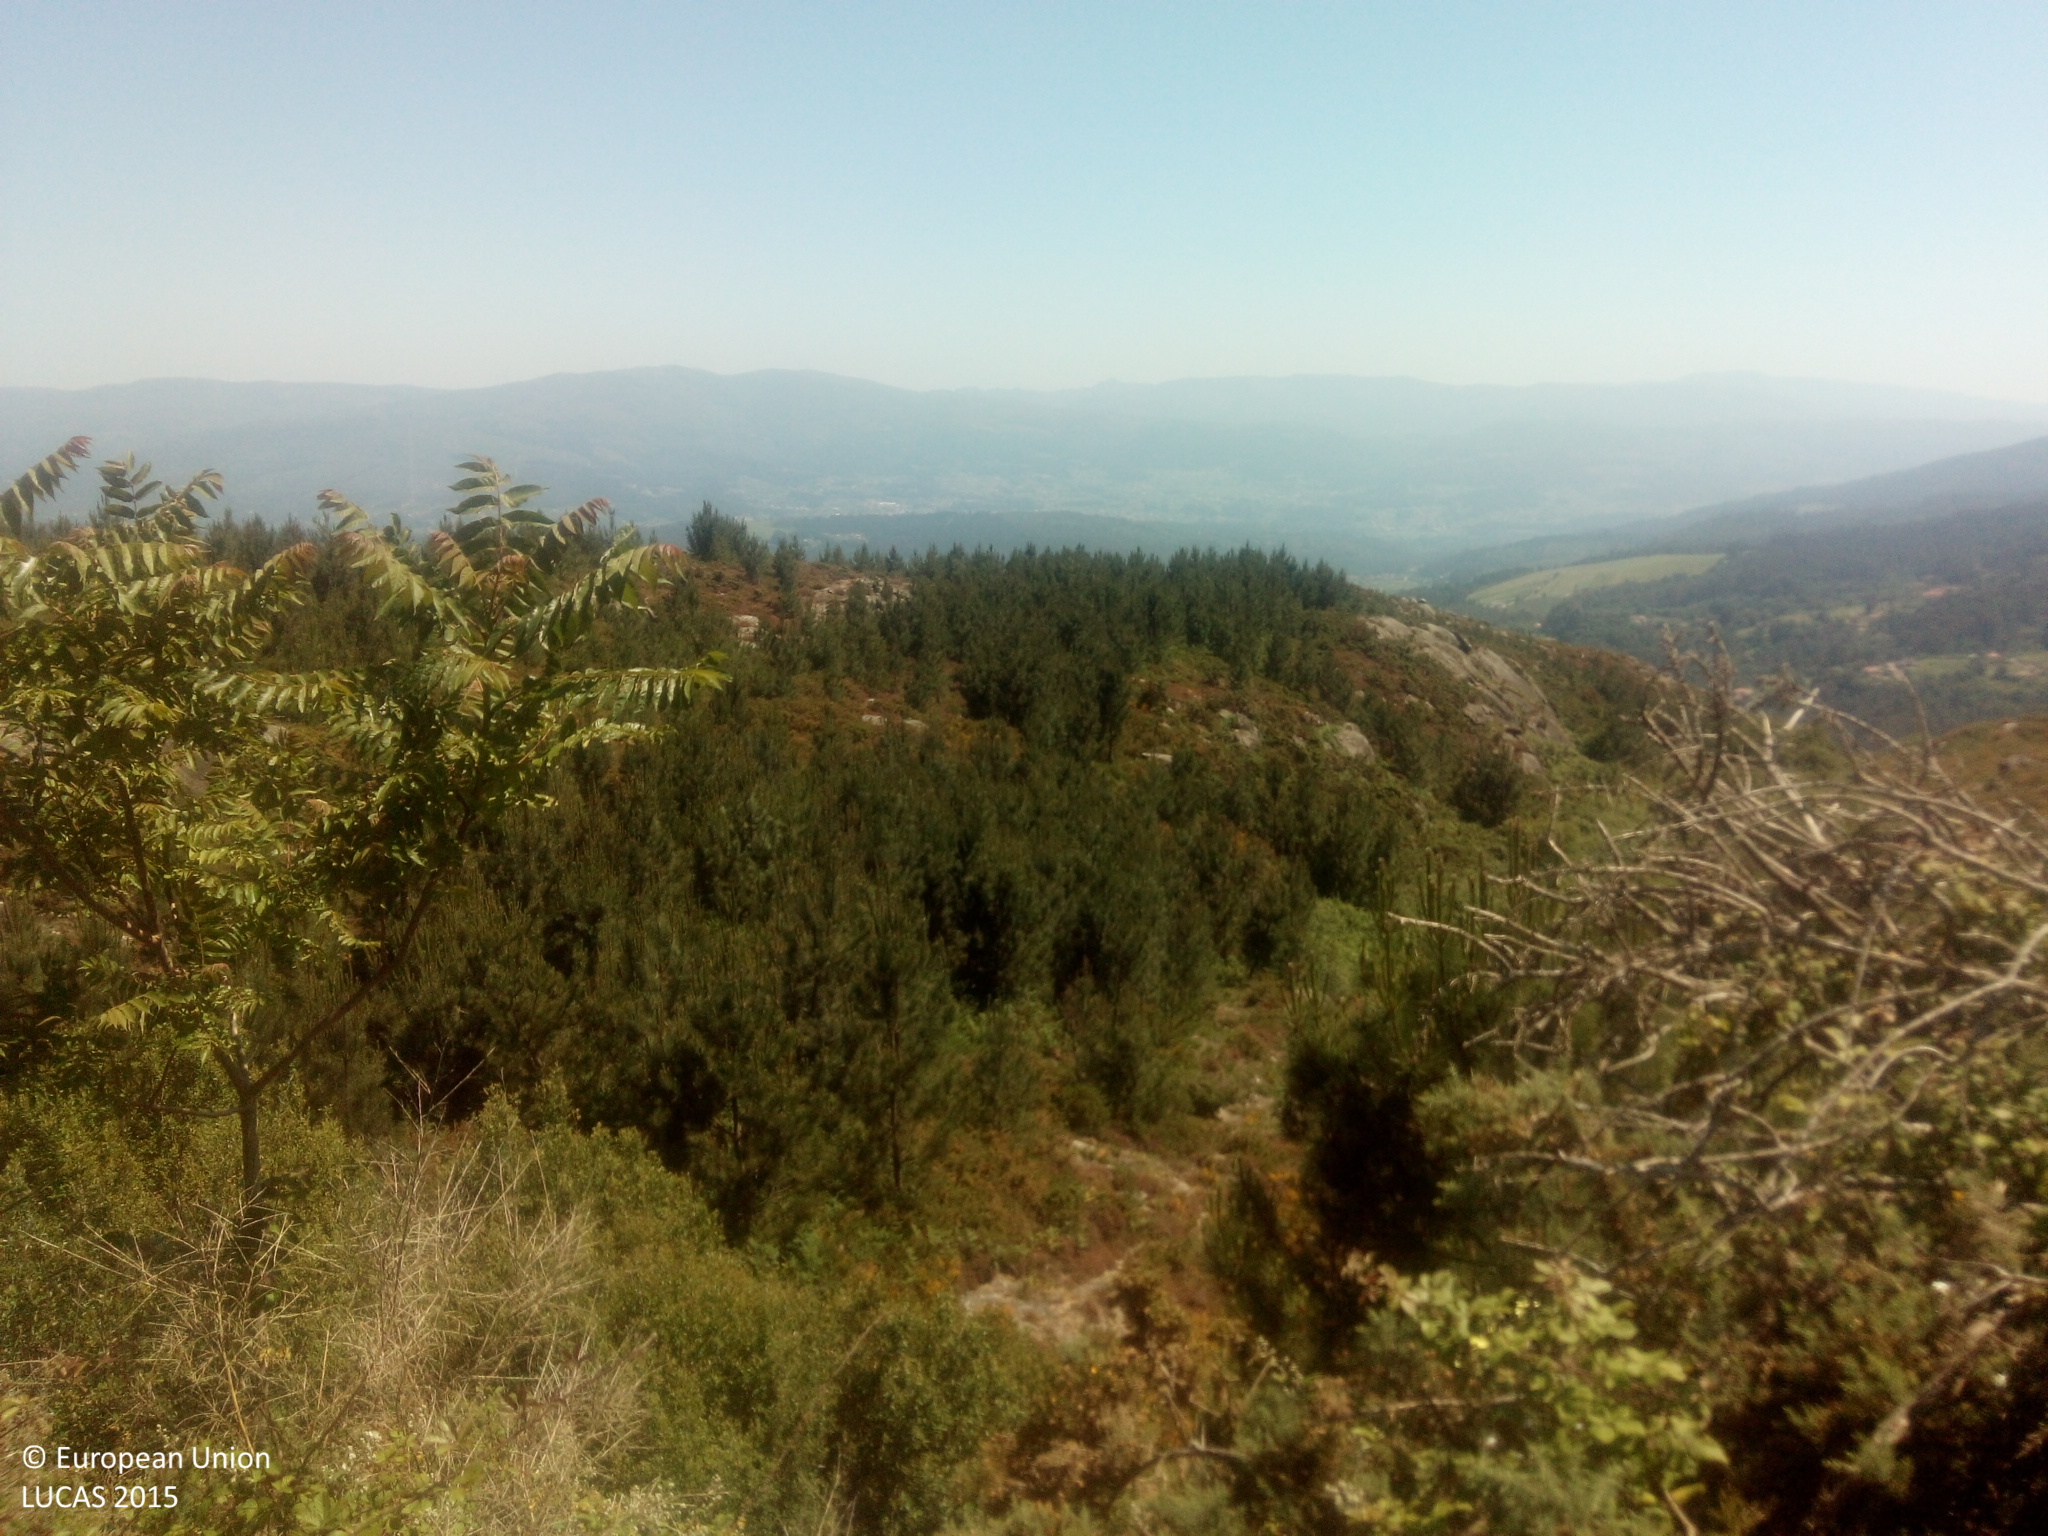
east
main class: Shrubland
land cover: Shrubland without tree cover
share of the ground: > 75 %
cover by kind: shrubs 70 %, consolidated bare surface 30 %
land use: Semi-natural and natural areas not in use
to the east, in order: Shrubland without tree cover; Rock outcrops; Shrubland without tree cover
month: June
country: ES
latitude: 42.1869
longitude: -8.3110
